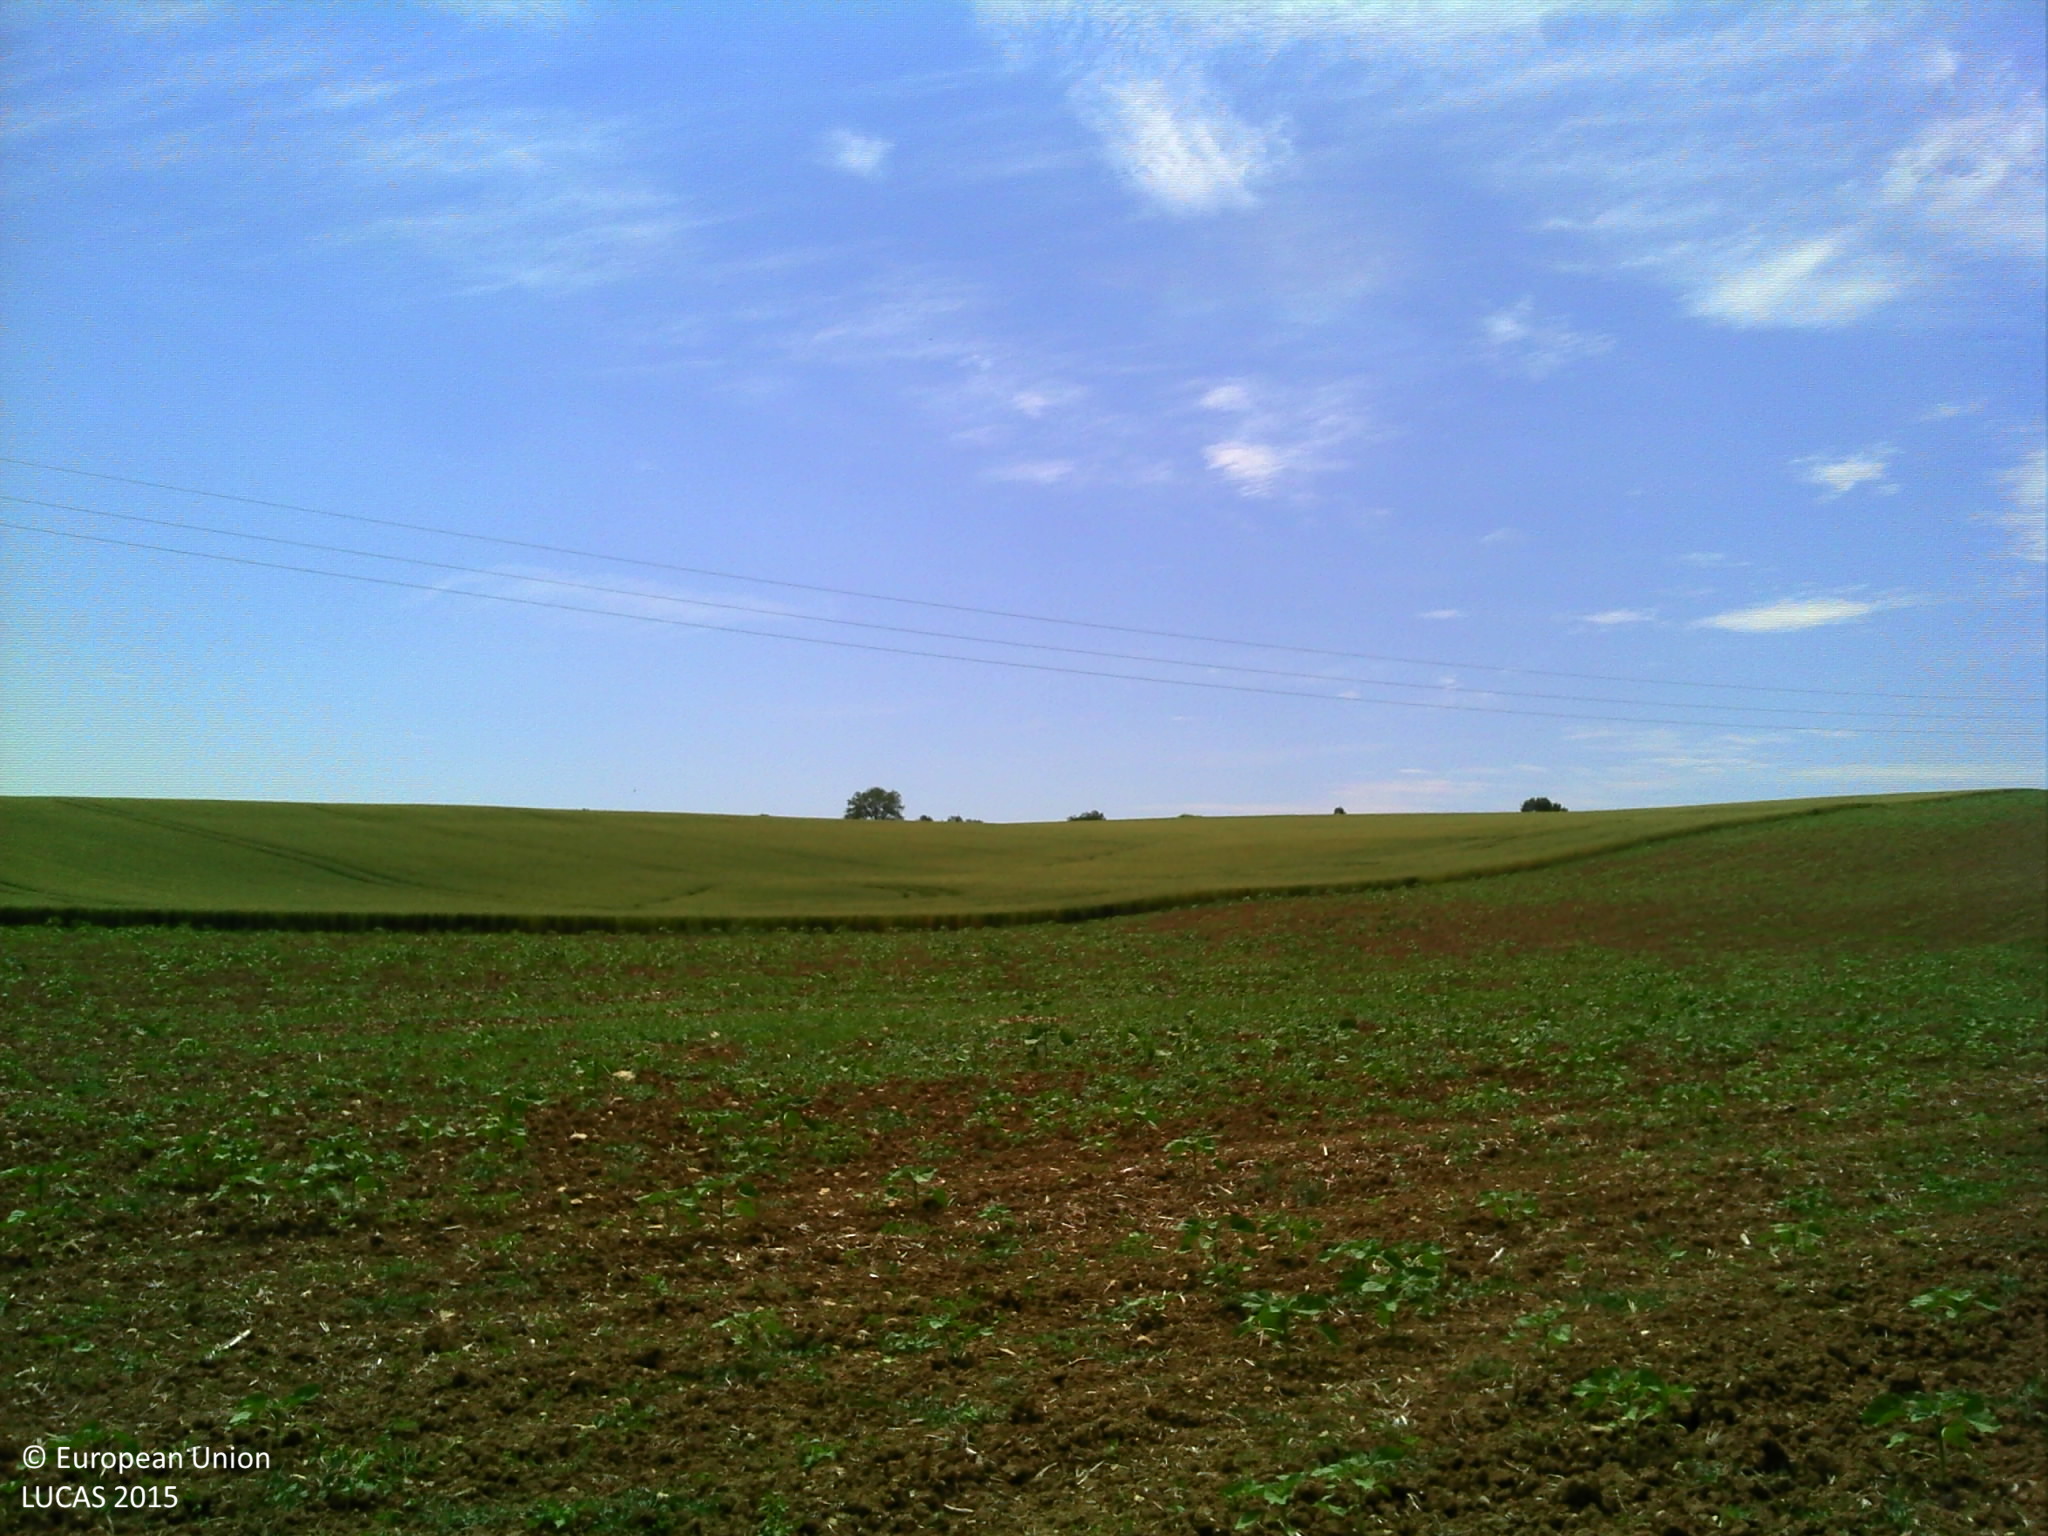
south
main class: Cropland
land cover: Sunflower
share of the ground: < 10 %
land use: Agriculture (excluding fallow land and kitchen gardens)
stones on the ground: > 50 %
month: June
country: FR
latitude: 48.3089
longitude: 0.1704
